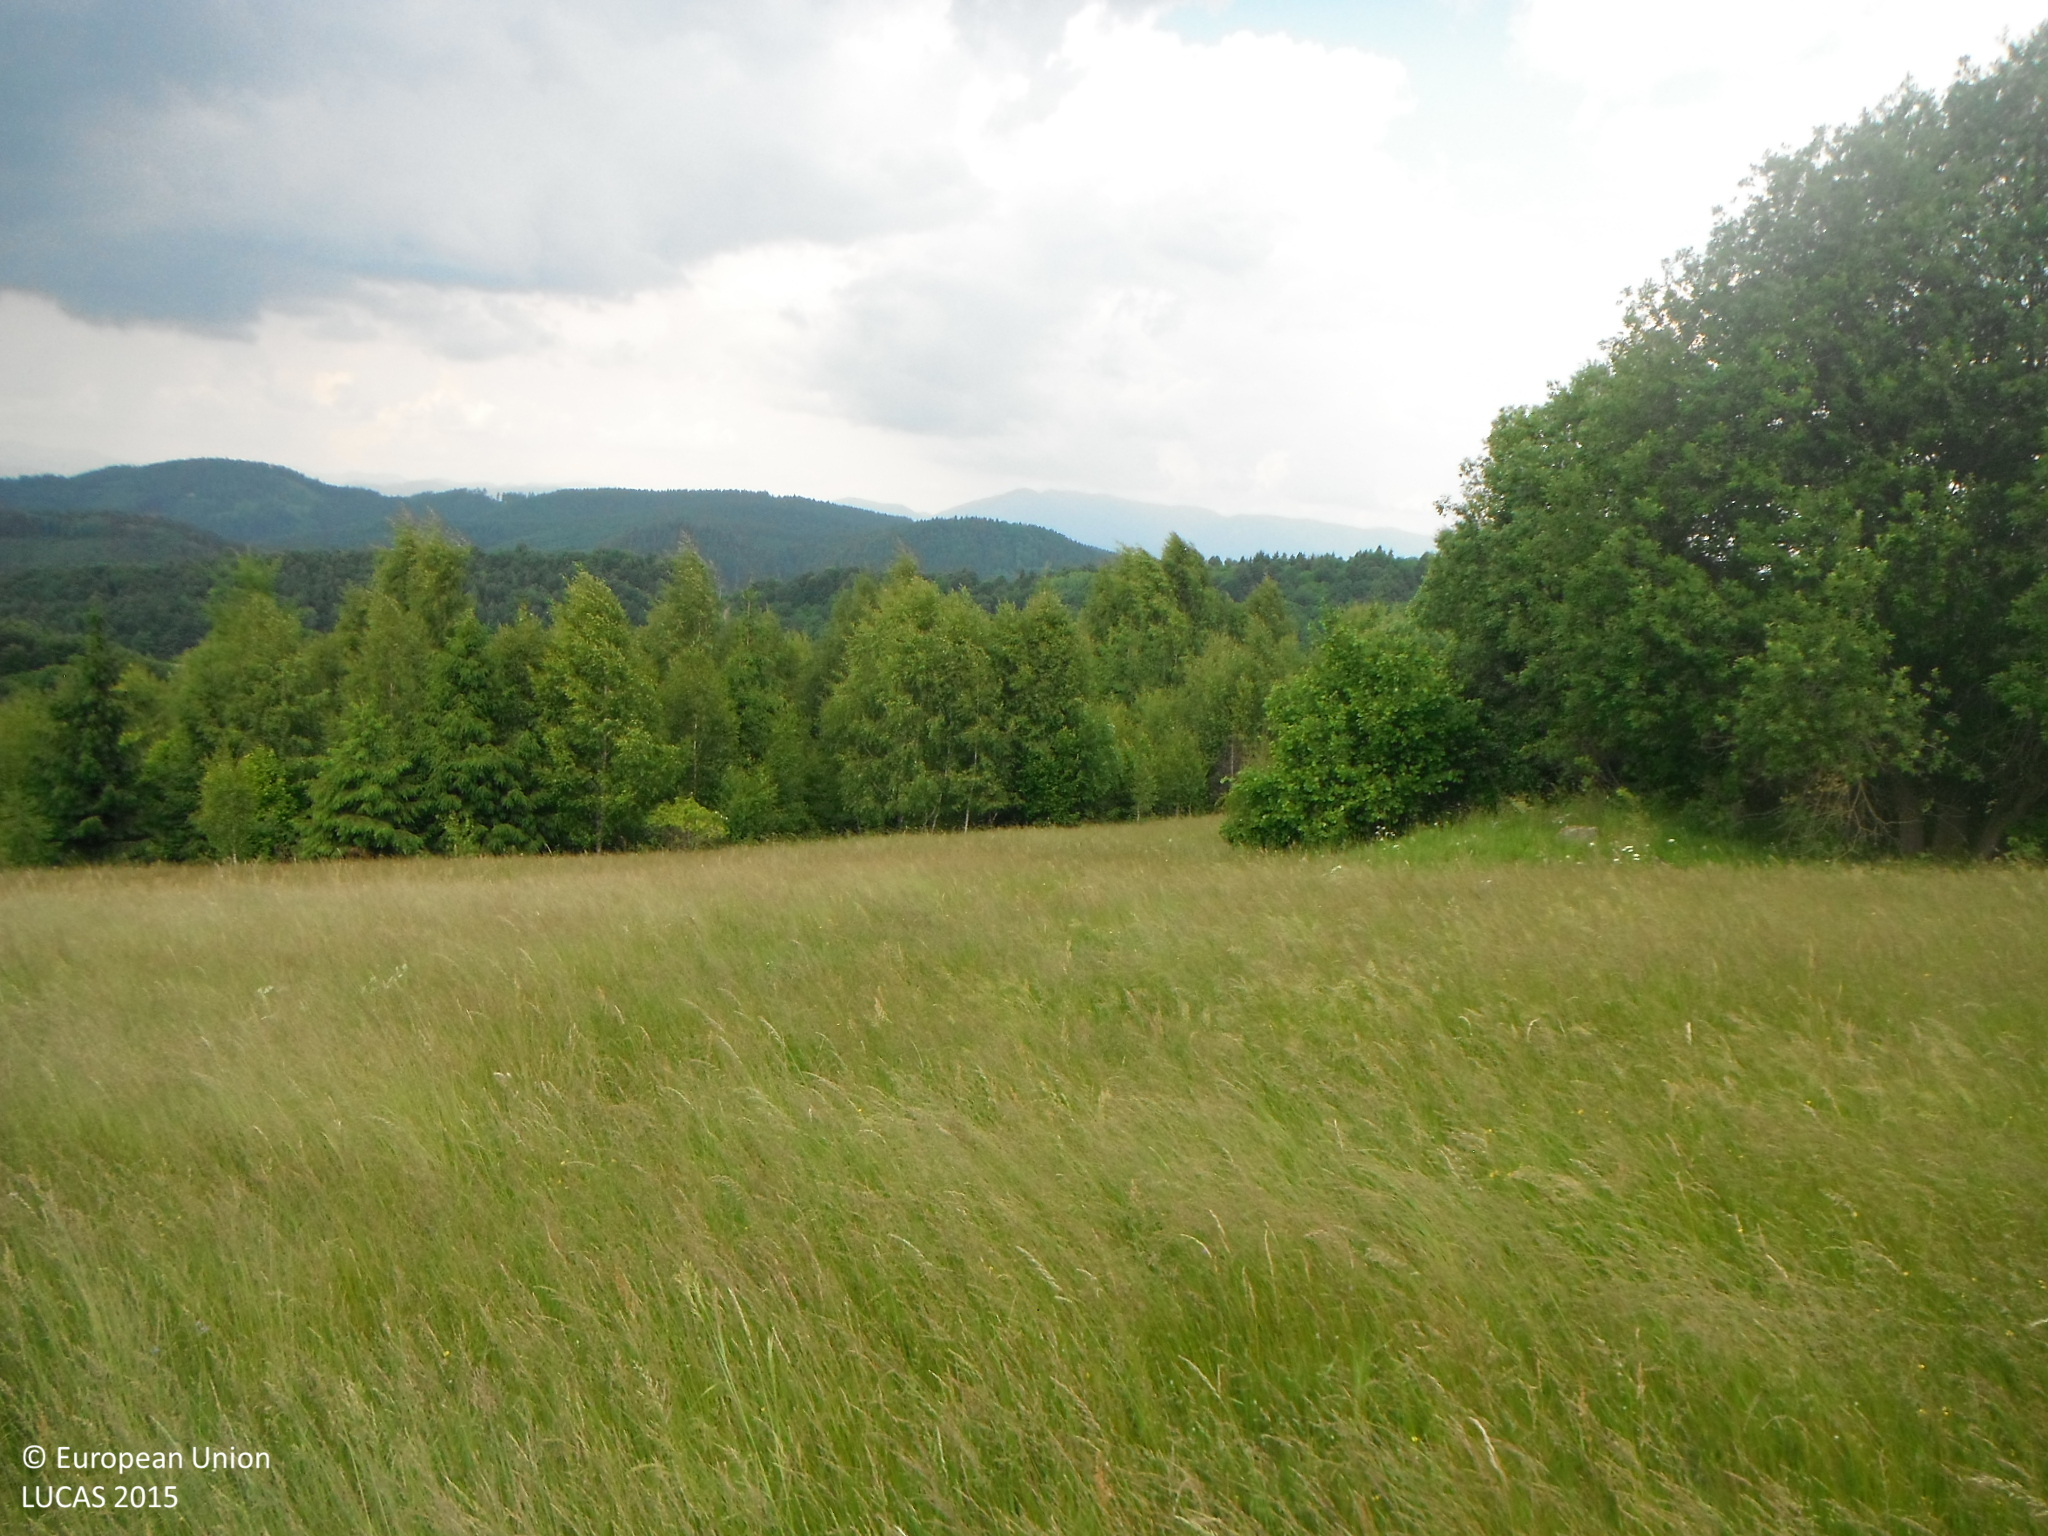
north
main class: Grassland
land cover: Grassland without tree/shrub cover
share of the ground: > 75 %
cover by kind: herbaceous plants 100 %
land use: Agriculture (excluding fallow land and kitchen gardens)
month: June
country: SK
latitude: 48.6763
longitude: 19.3540
